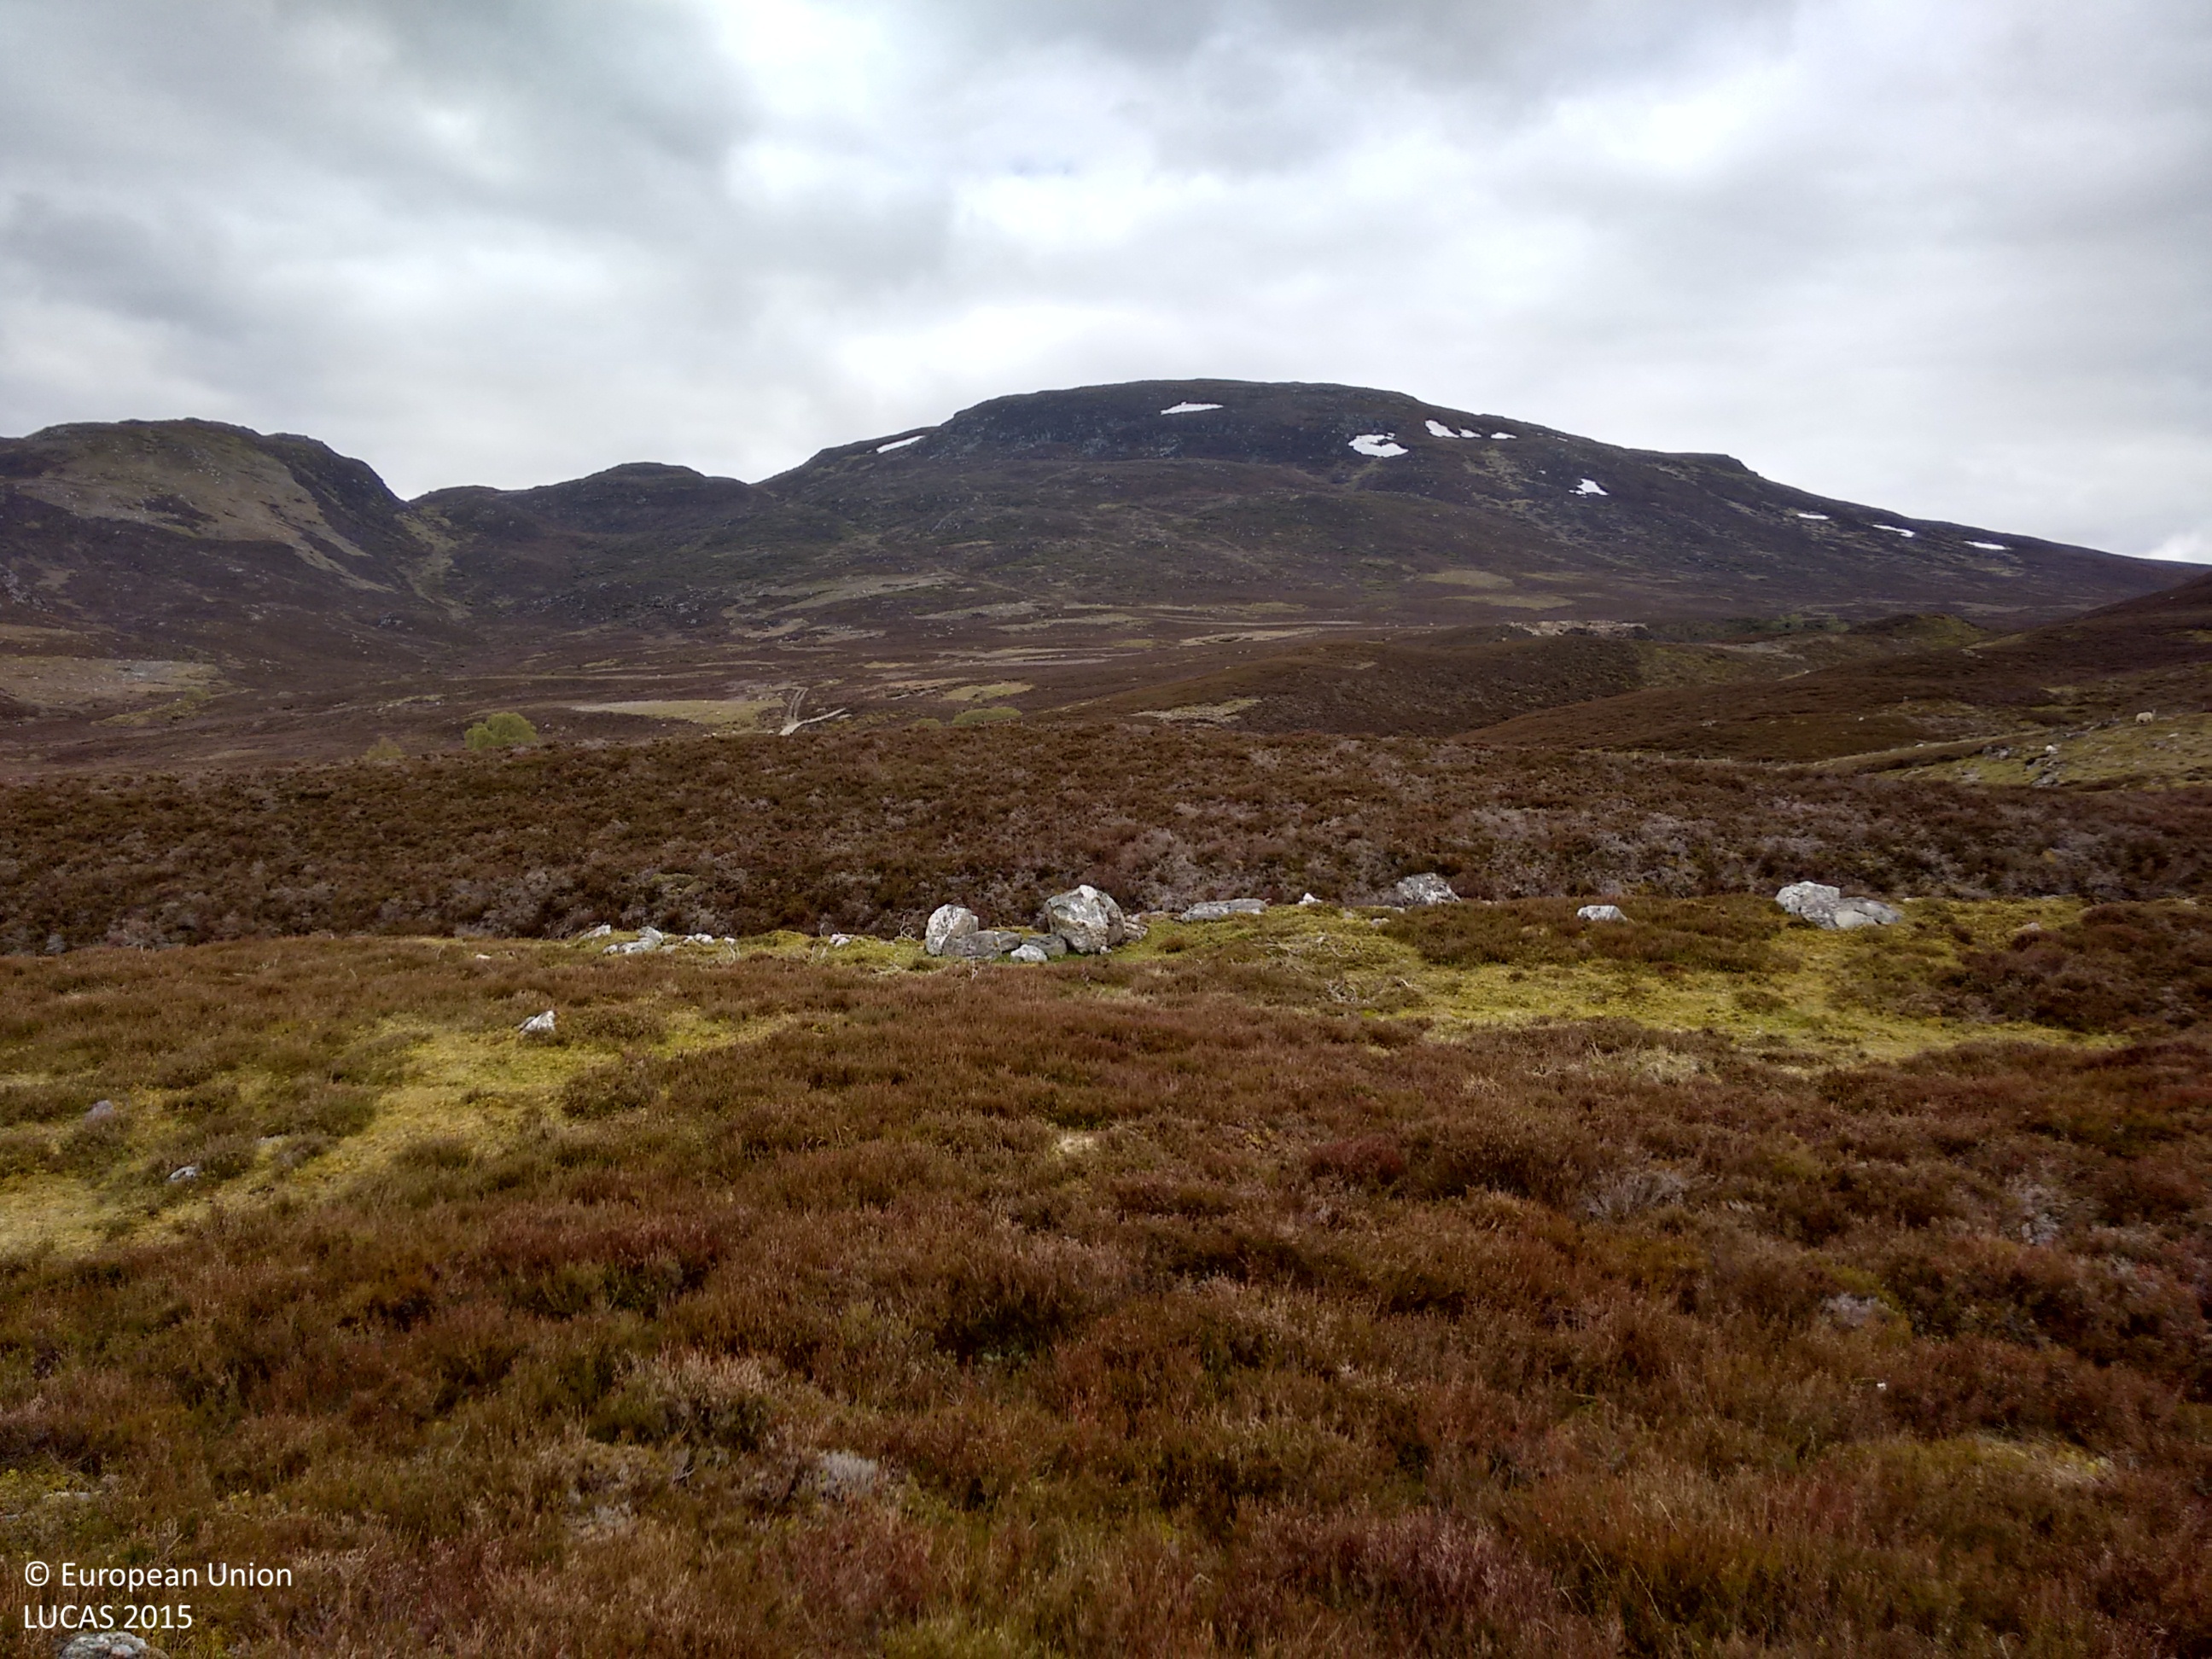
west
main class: Shrubland
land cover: Shrubland without tree cover
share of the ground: > 75 %
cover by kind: shrubs 90 %, lichens and mosses 5 %
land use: Agriculture (excluding fallow land and kitchen gardens)
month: June
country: GB
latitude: 57.1083
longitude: -4.0683
